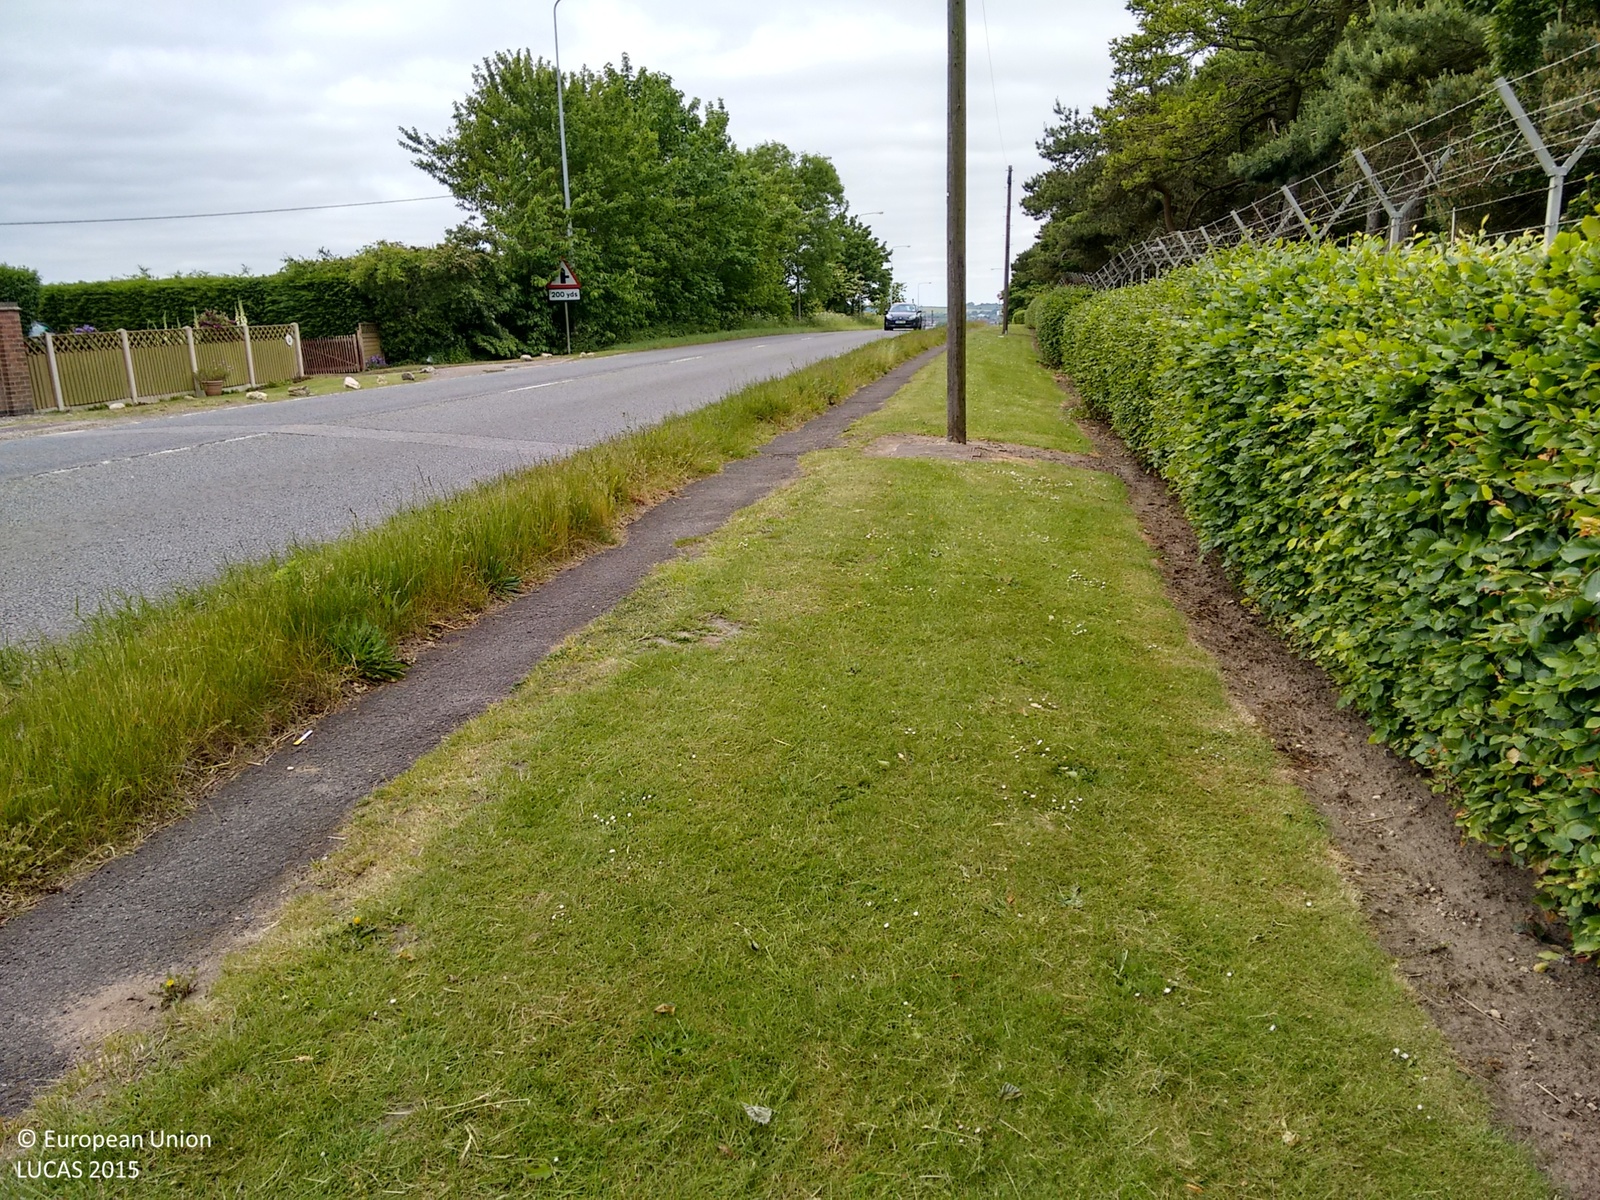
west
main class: Woodland
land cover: Broadleaved woodland
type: mesophytic deciduous forest
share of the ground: > 75 %
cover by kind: broadleaved forest trees 100 %
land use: Community services
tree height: > 5 m
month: June
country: GB
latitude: 52.8983
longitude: -0.6086
